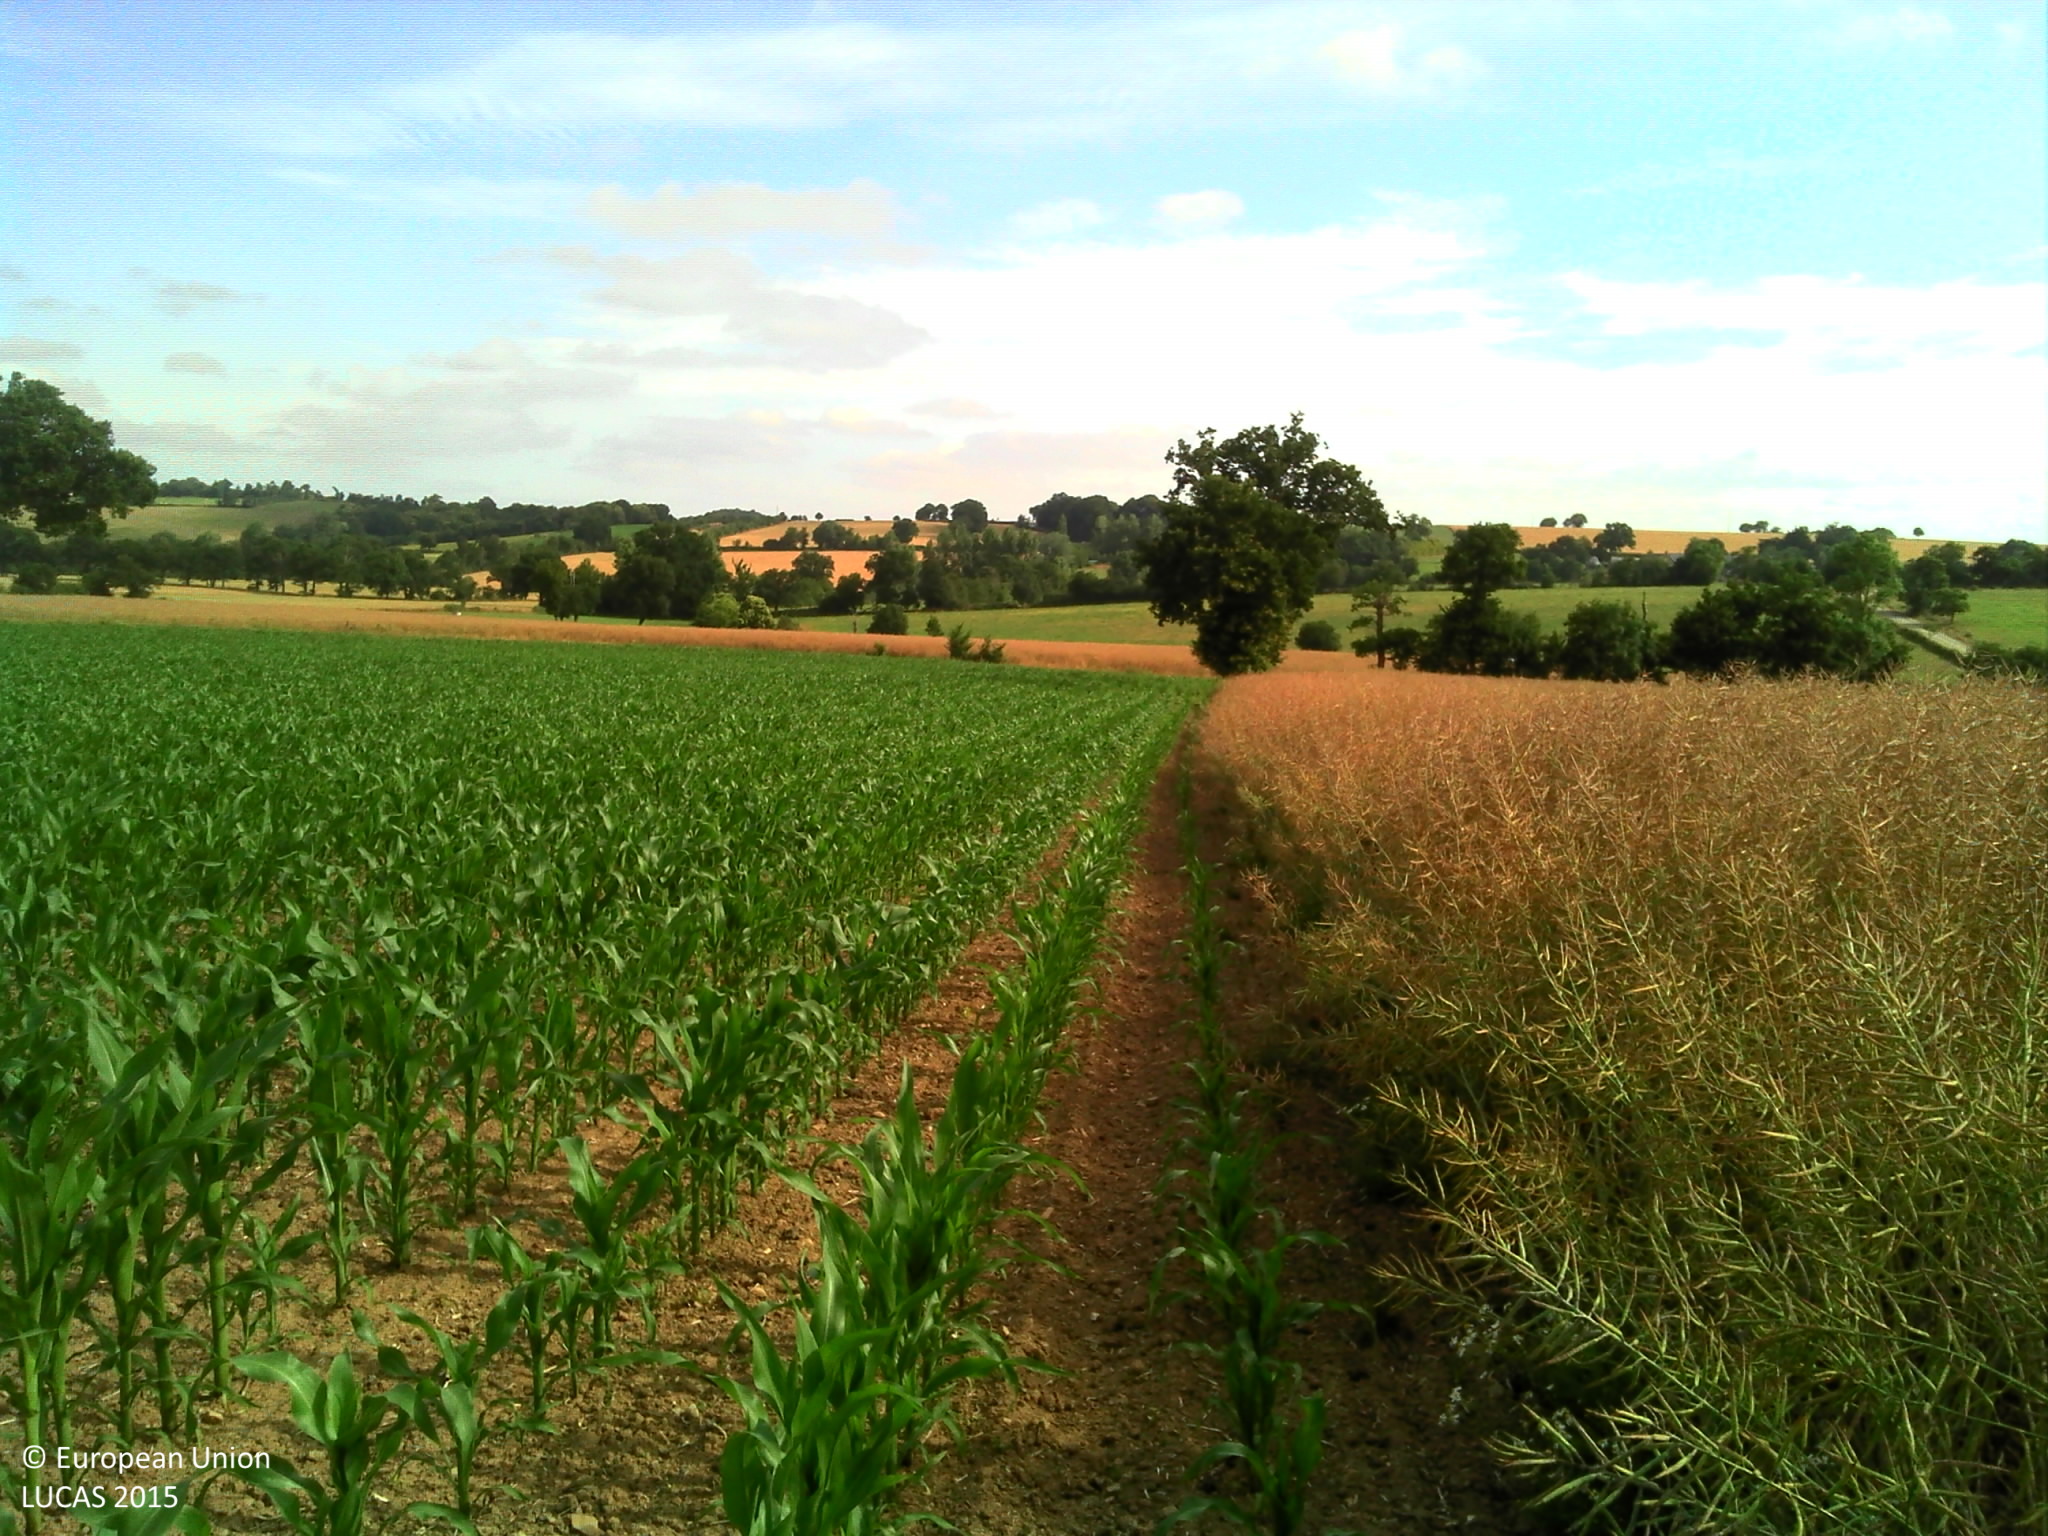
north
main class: Cropland
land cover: Rape and turnip rape
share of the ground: > 75 %
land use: Agriculture (excluding fallow land and kitchen gardens)
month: June
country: FR
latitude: 47.8830
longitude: -1.5862
